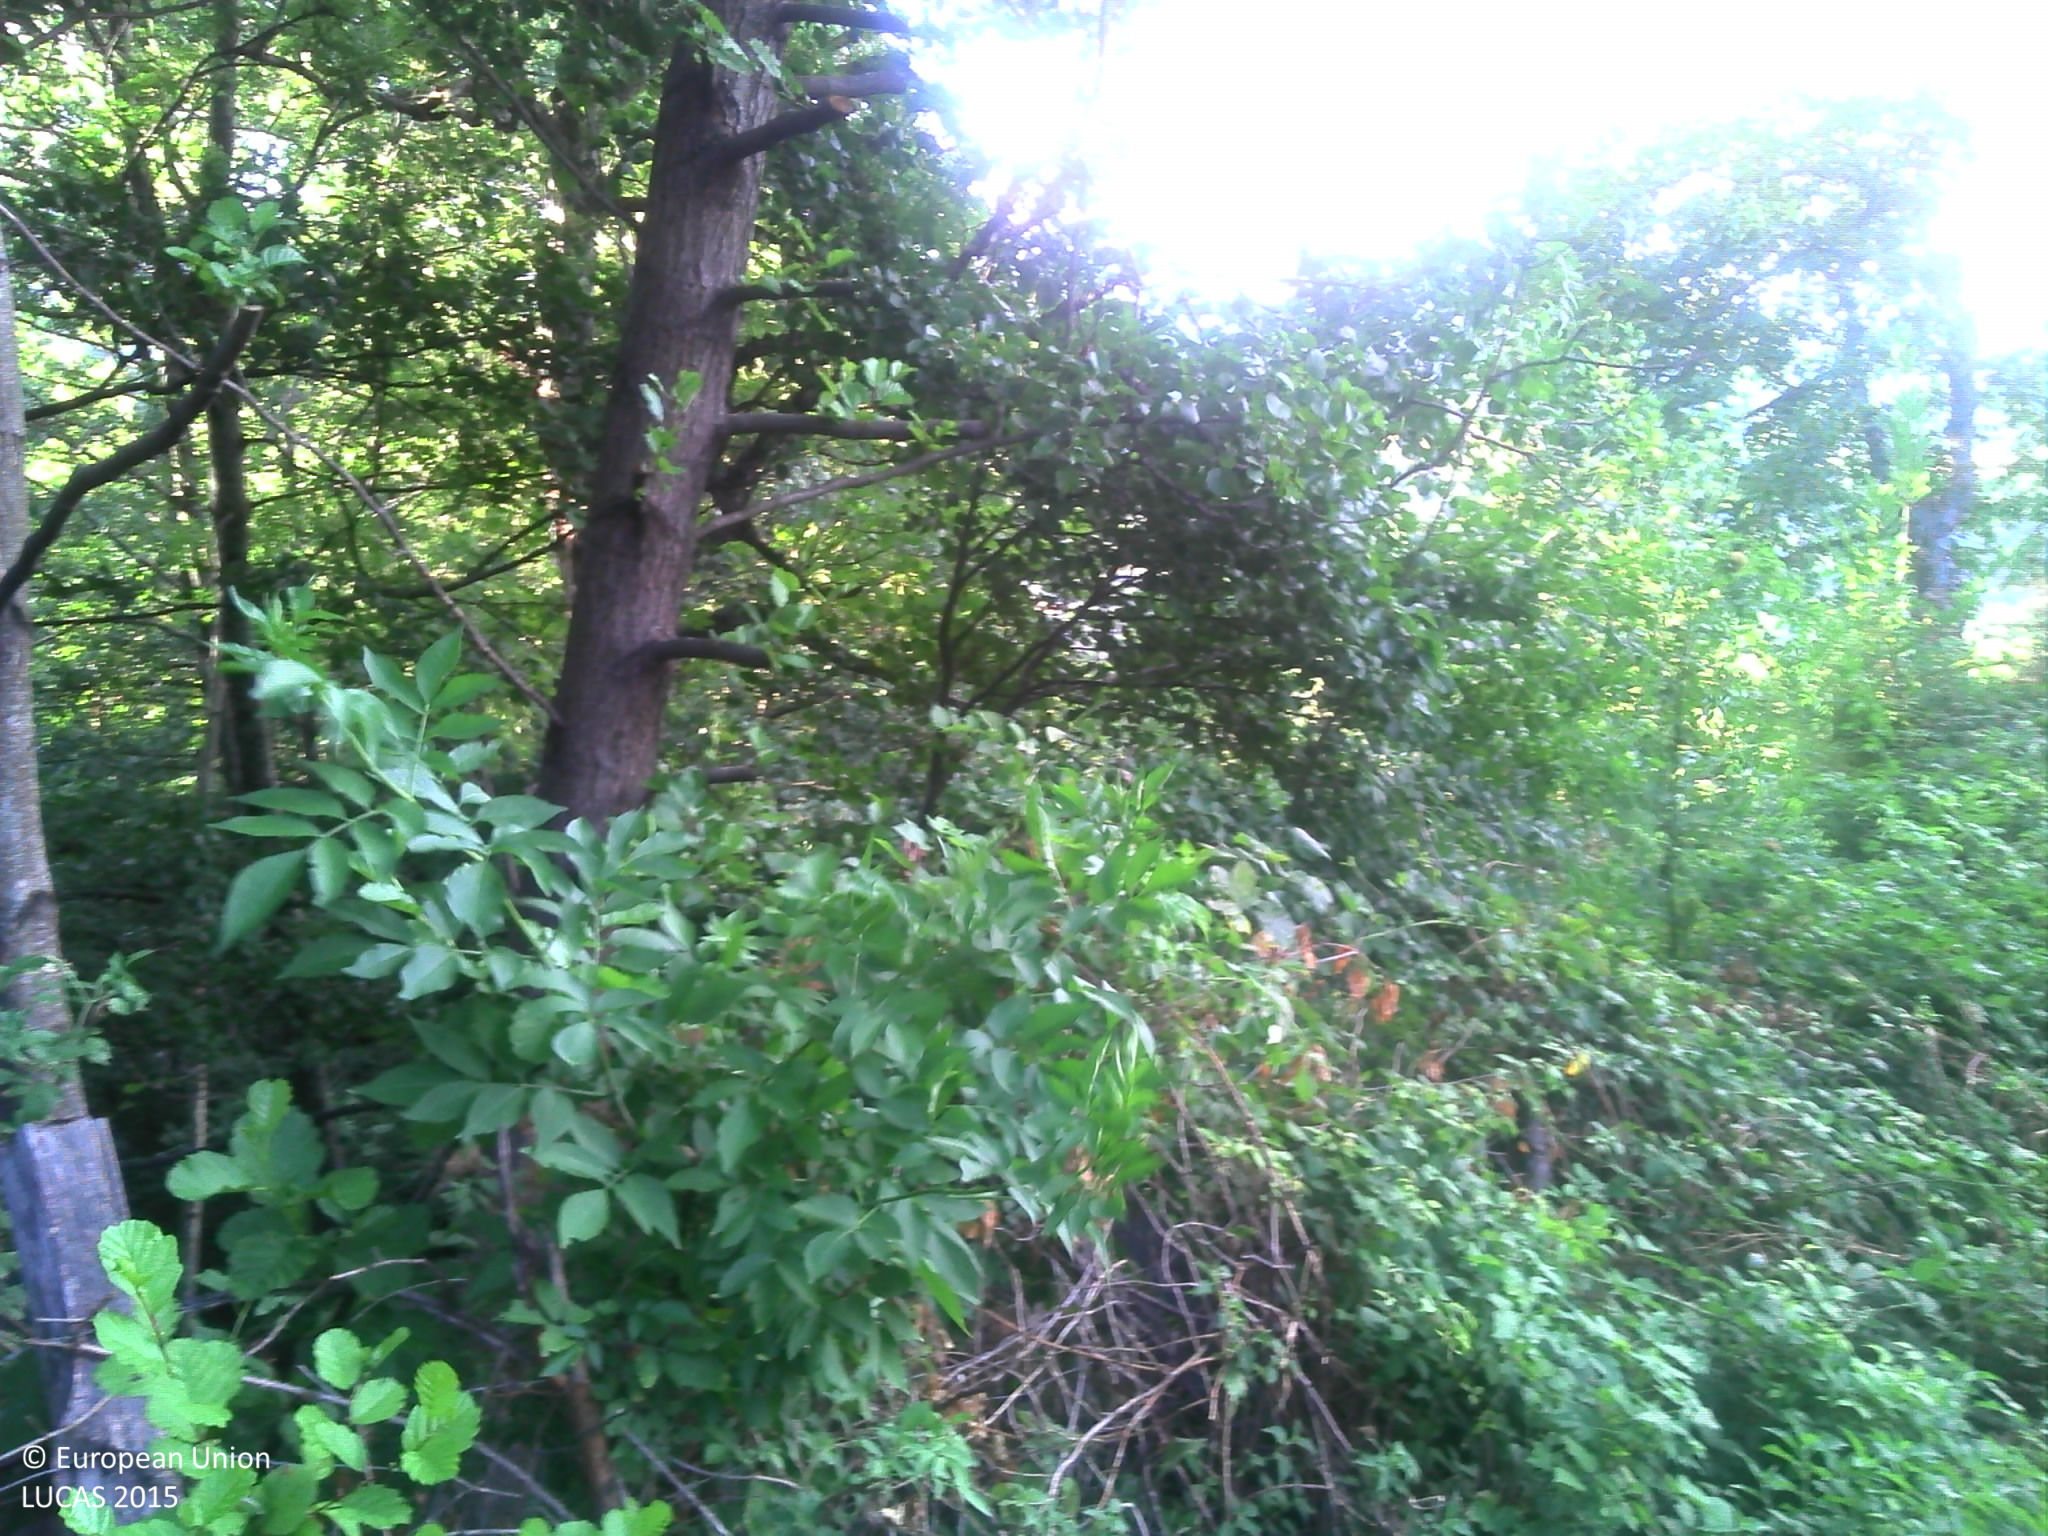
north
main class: Woodland
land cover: Broadleaved woodland
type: floodplain forest
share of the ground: > 75 %
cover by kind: broadleaved forest trees 80 %, shrubs 20 %
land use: Semi-natural and natural areas not in use
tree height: > 5 m
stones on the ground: < 10 %
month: September
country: FR
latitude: 45.1482
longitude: 4.5740
